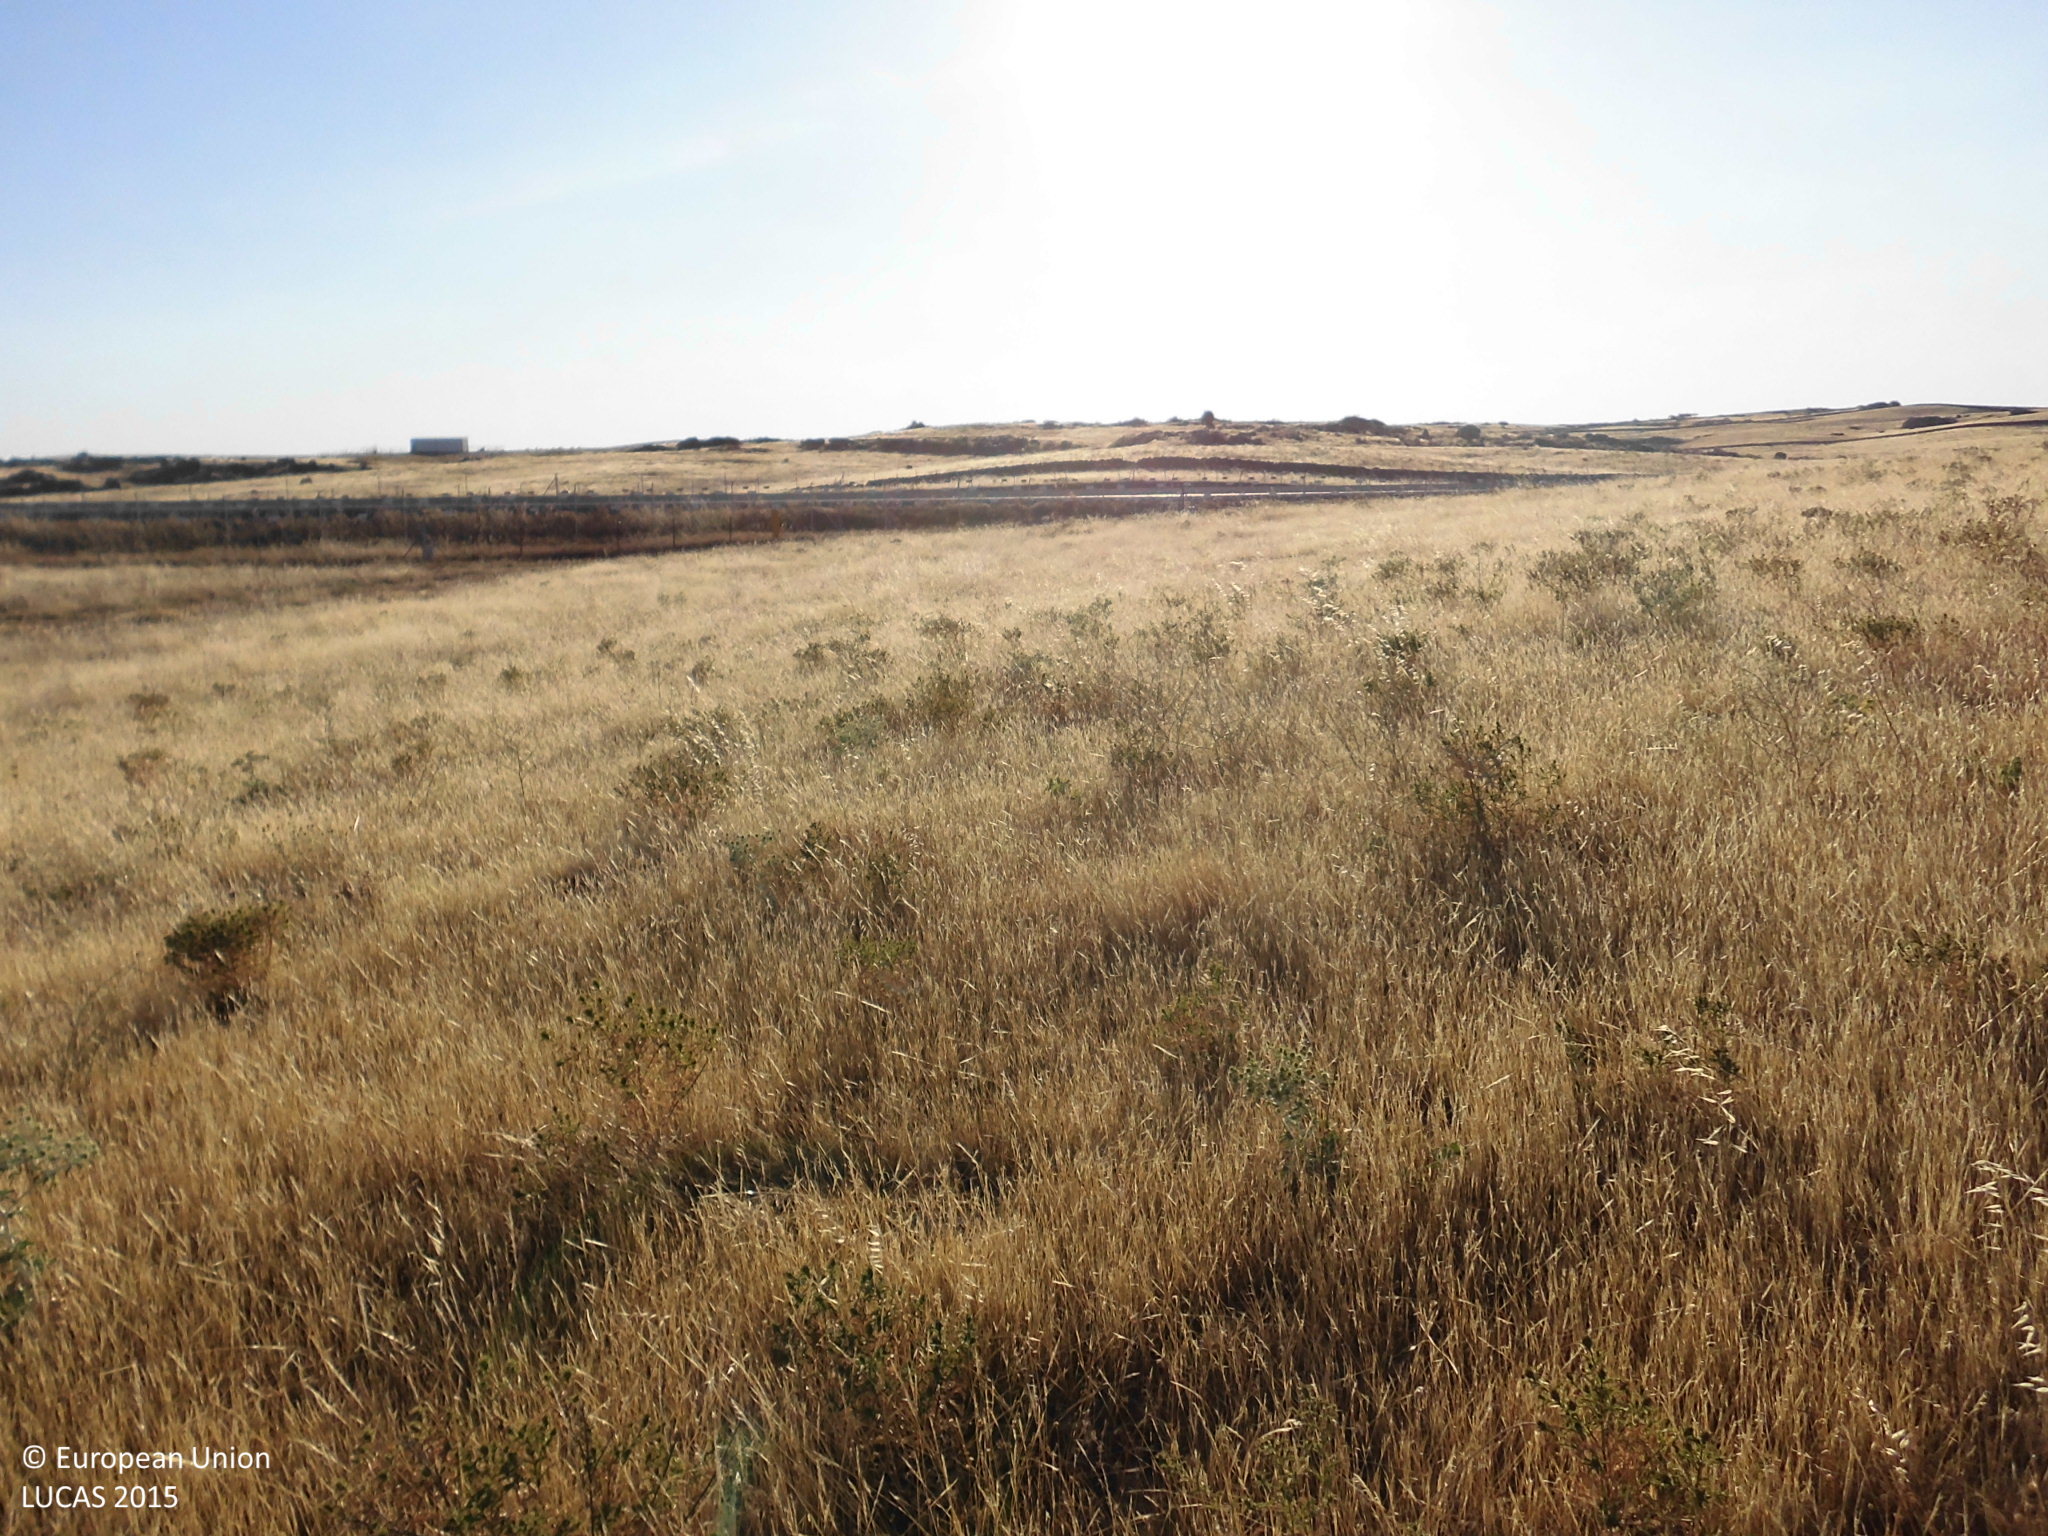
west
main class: Grassland
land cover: Grassland without tree/shrub cover
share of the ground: > 75 %
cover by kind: herbaceous plants 100 %
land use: Agriculture (excluding fallow land and kitchen gardens)
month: June
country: ES
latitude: 39.6172
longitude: -6.4855
